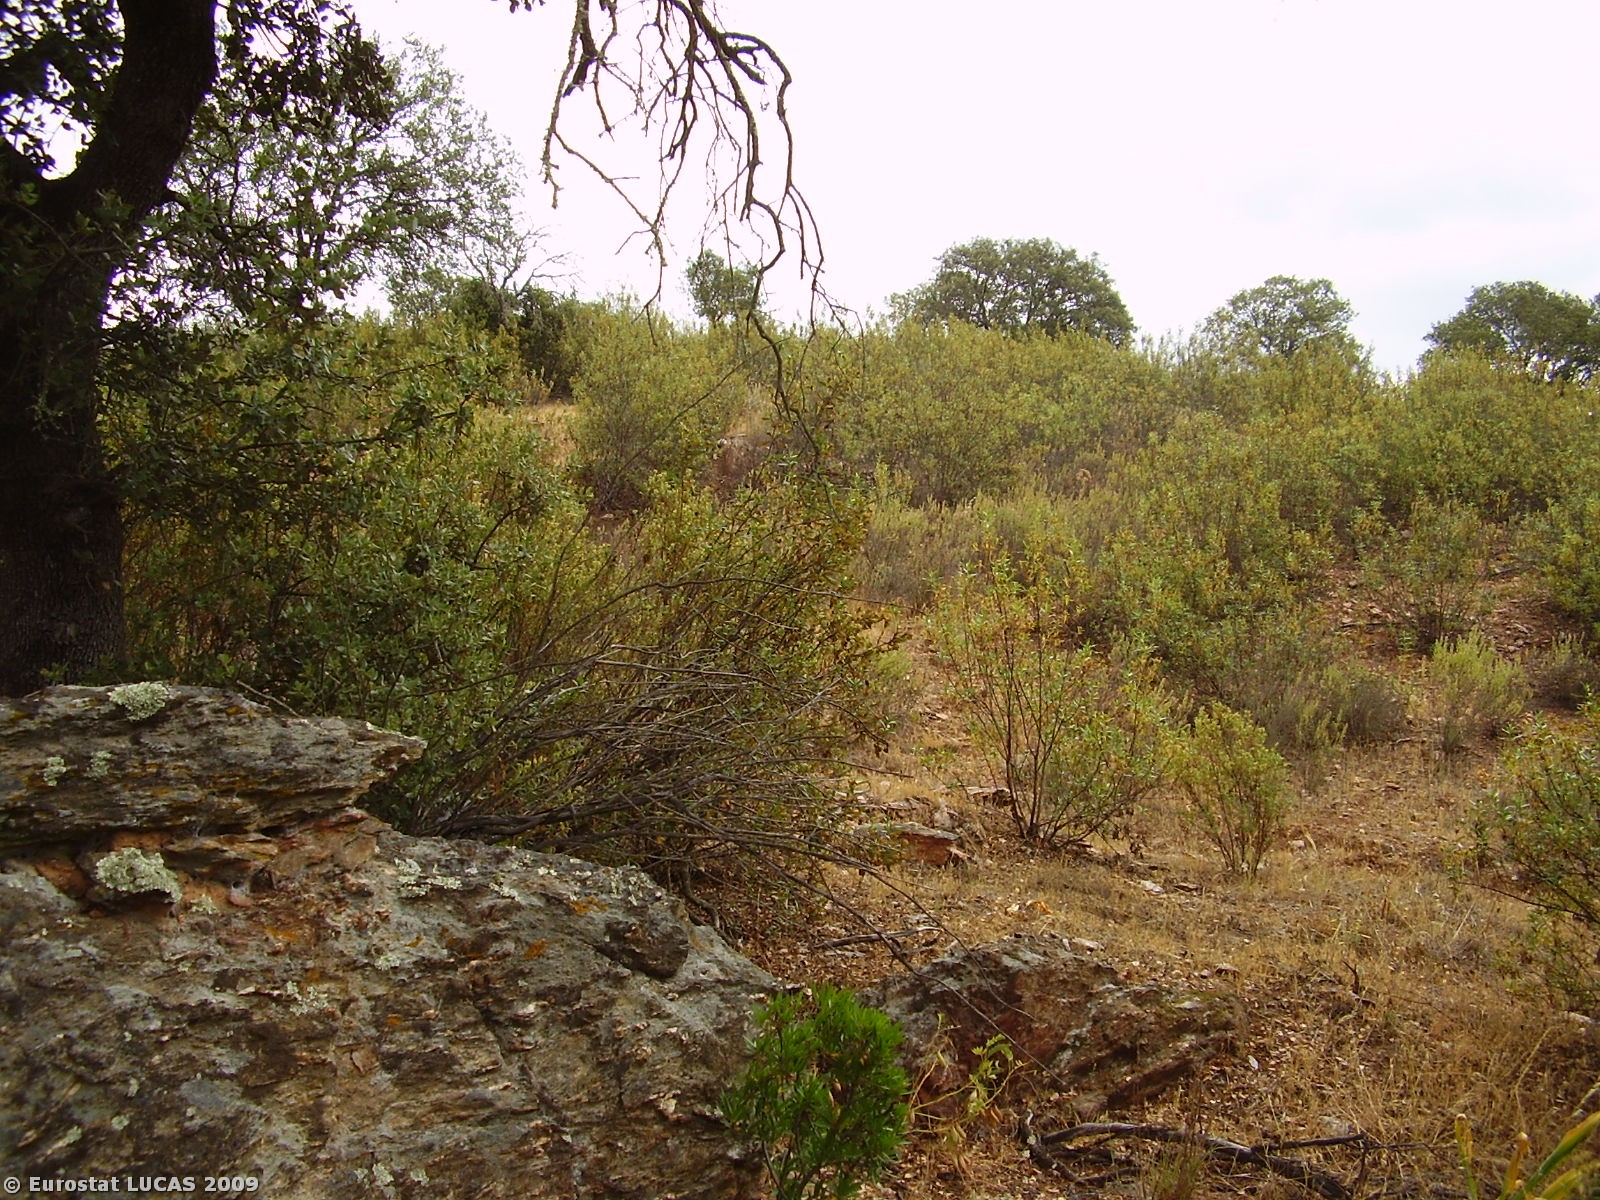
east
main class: Shrubland
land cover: Shrubland with sparse tree cover
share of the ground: 50 - 75 %
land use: Fallow land
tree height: > 5 m
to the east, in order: Shrubland with sparse tree cover; Rivers and streams; Shrubland with sparse tree cover; Tracks; Shrubland with sparse tree cover
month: May
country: PT
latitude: 37.8242
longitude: -7.7325
